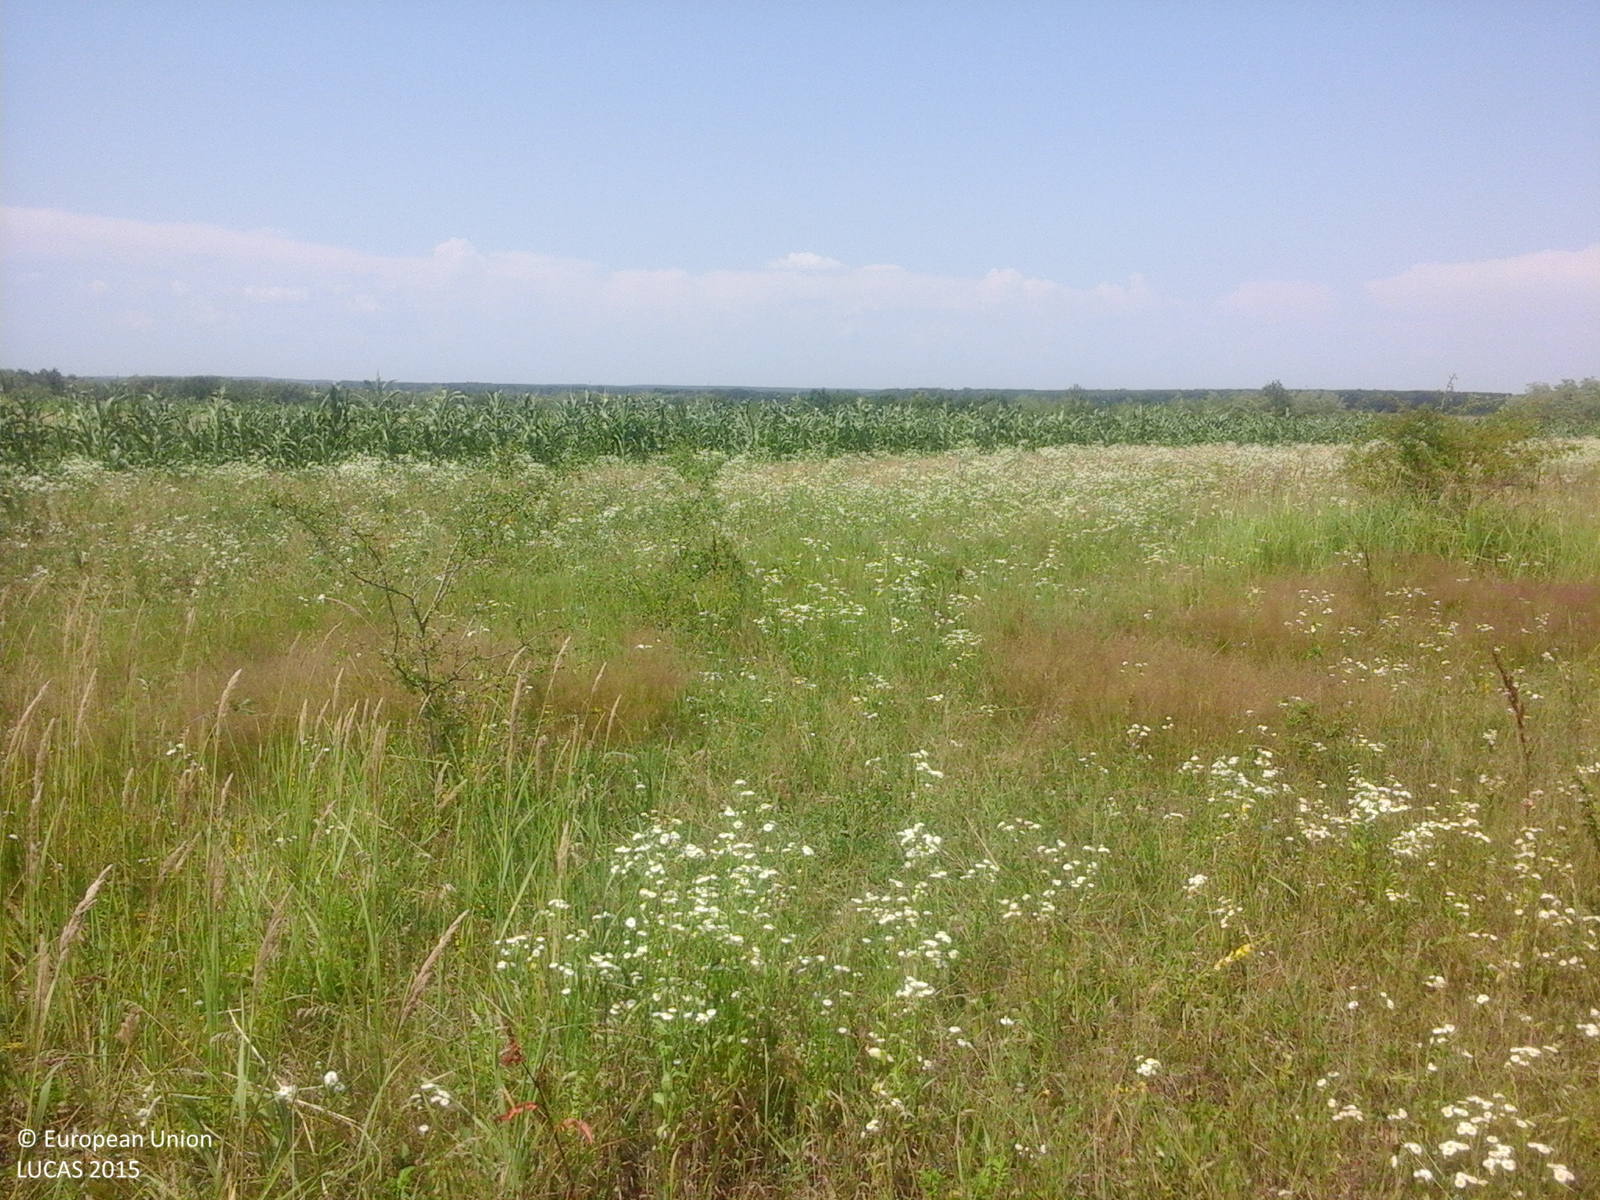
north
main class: Grassland
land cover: Grassland with sparse tree/shrub cover
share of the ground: > 75 %
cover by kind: herbaceous plants 95 %, broadleaved forest trees 5 %
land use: Agriculture (excluding fallow land and kitchen gardens)
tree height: < 5 m
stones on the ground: < 10 %
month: July
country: RO
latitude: 44.7657
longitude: 24.7985
